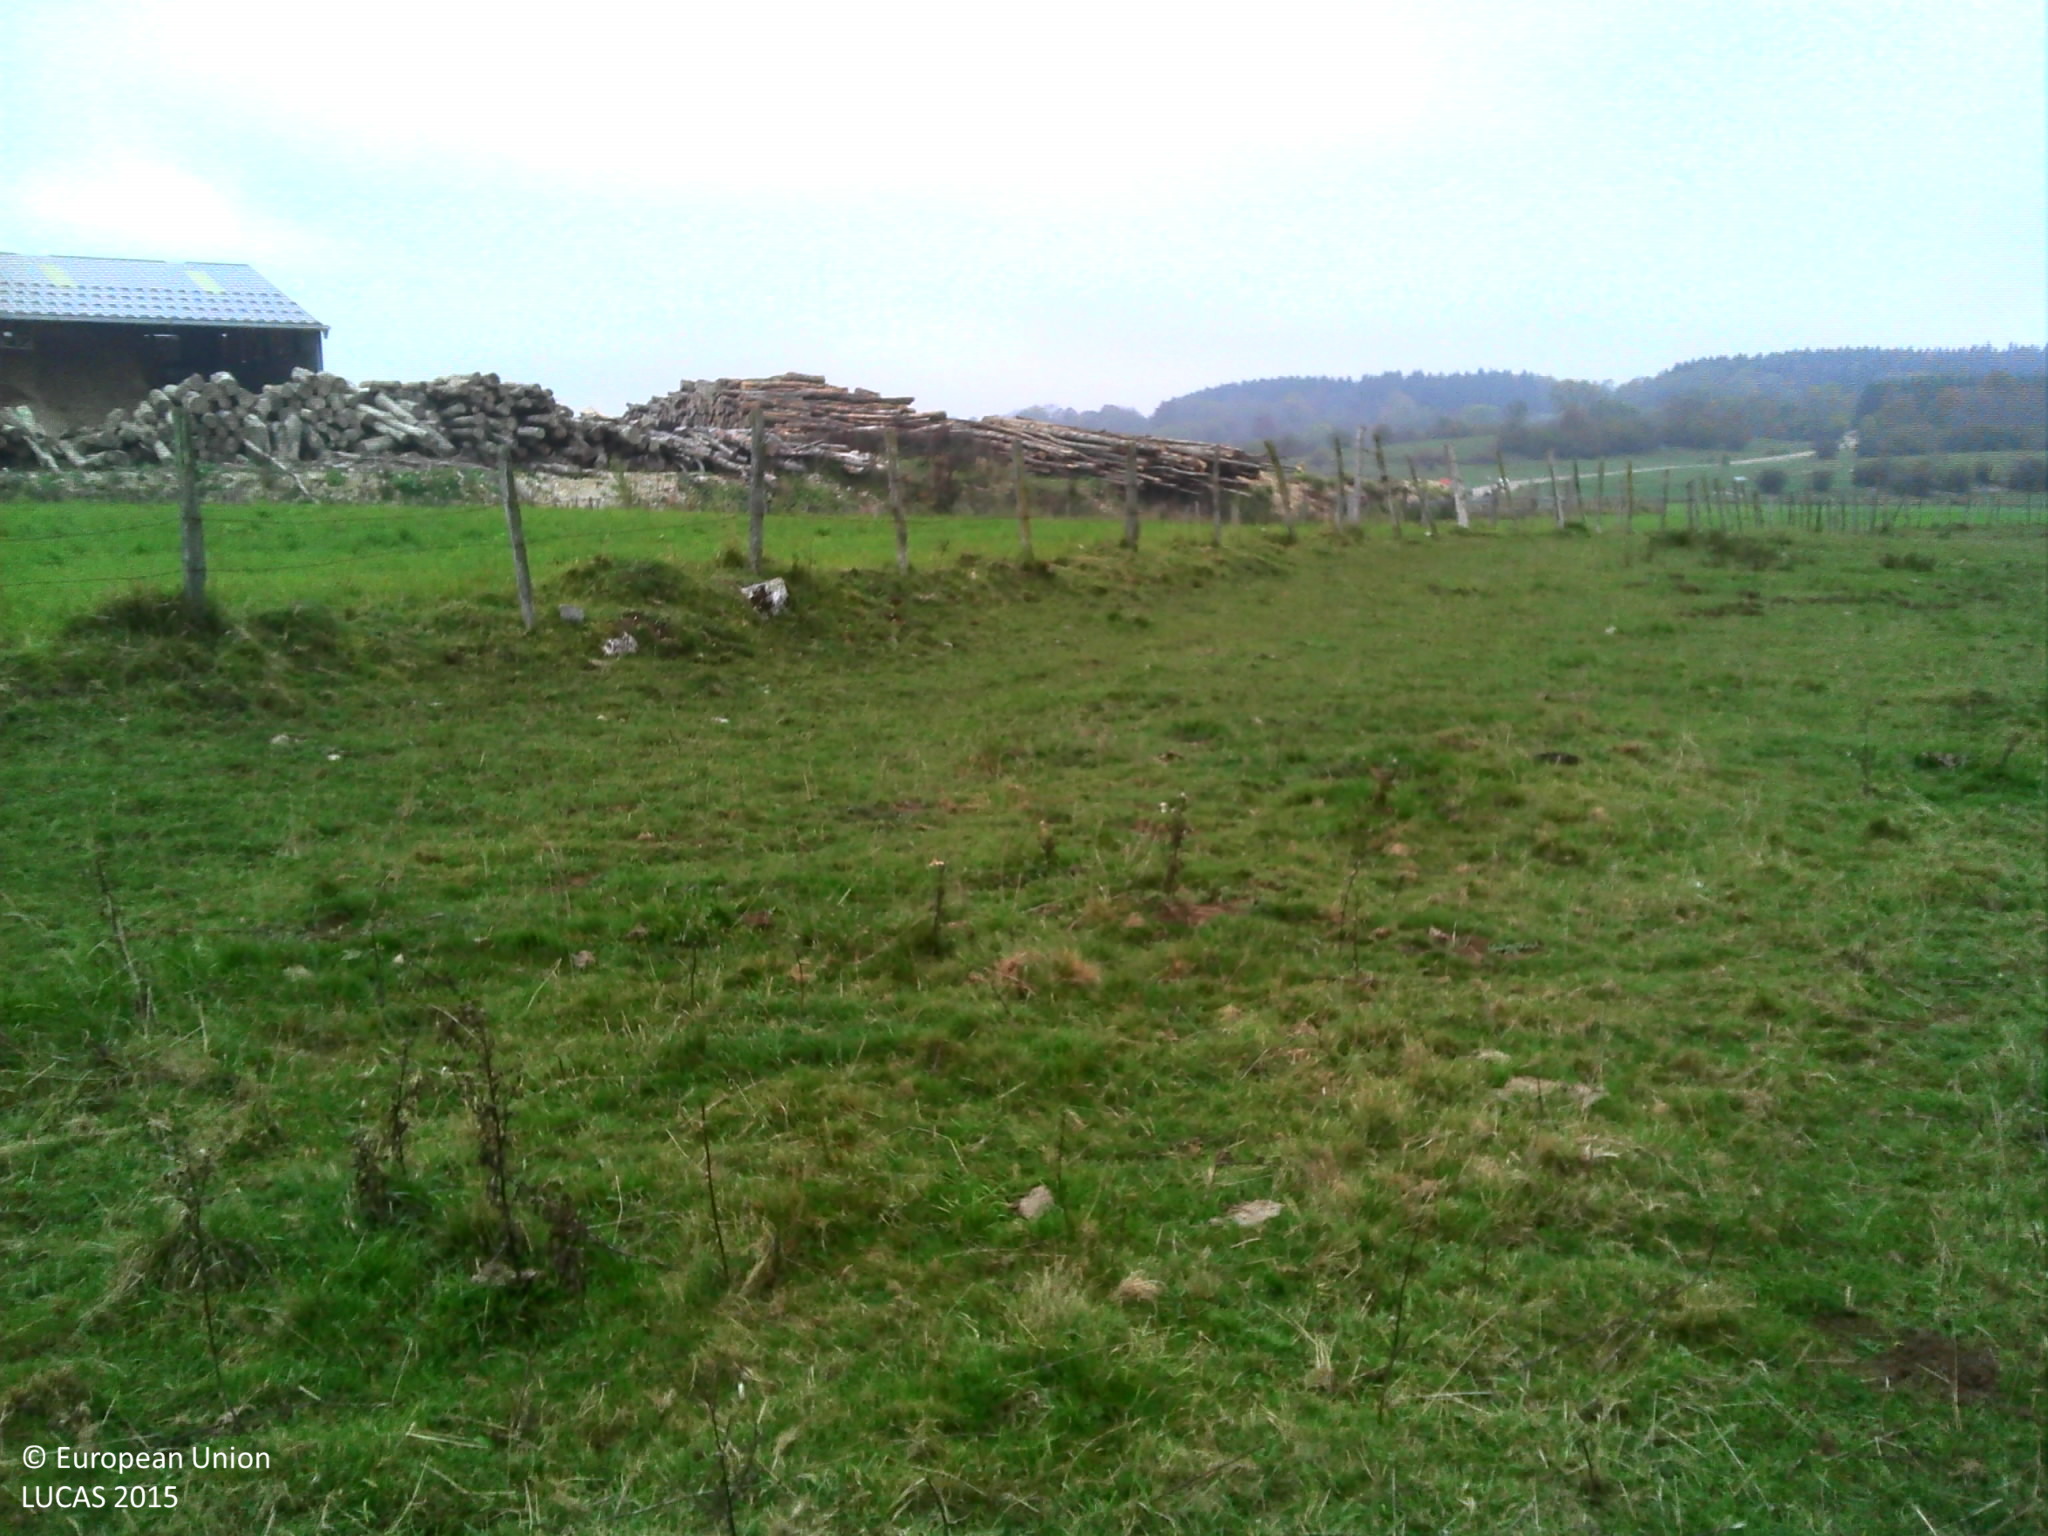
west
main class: Grassland
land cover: Grassland without tree/shrub cover
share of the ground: > 75 %
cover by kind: herbaceous plants 100 %
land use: Agriculture (excluding fallow land and kitchen gardens)
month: October
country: FR
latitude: 46.8772
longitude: 6.1579
